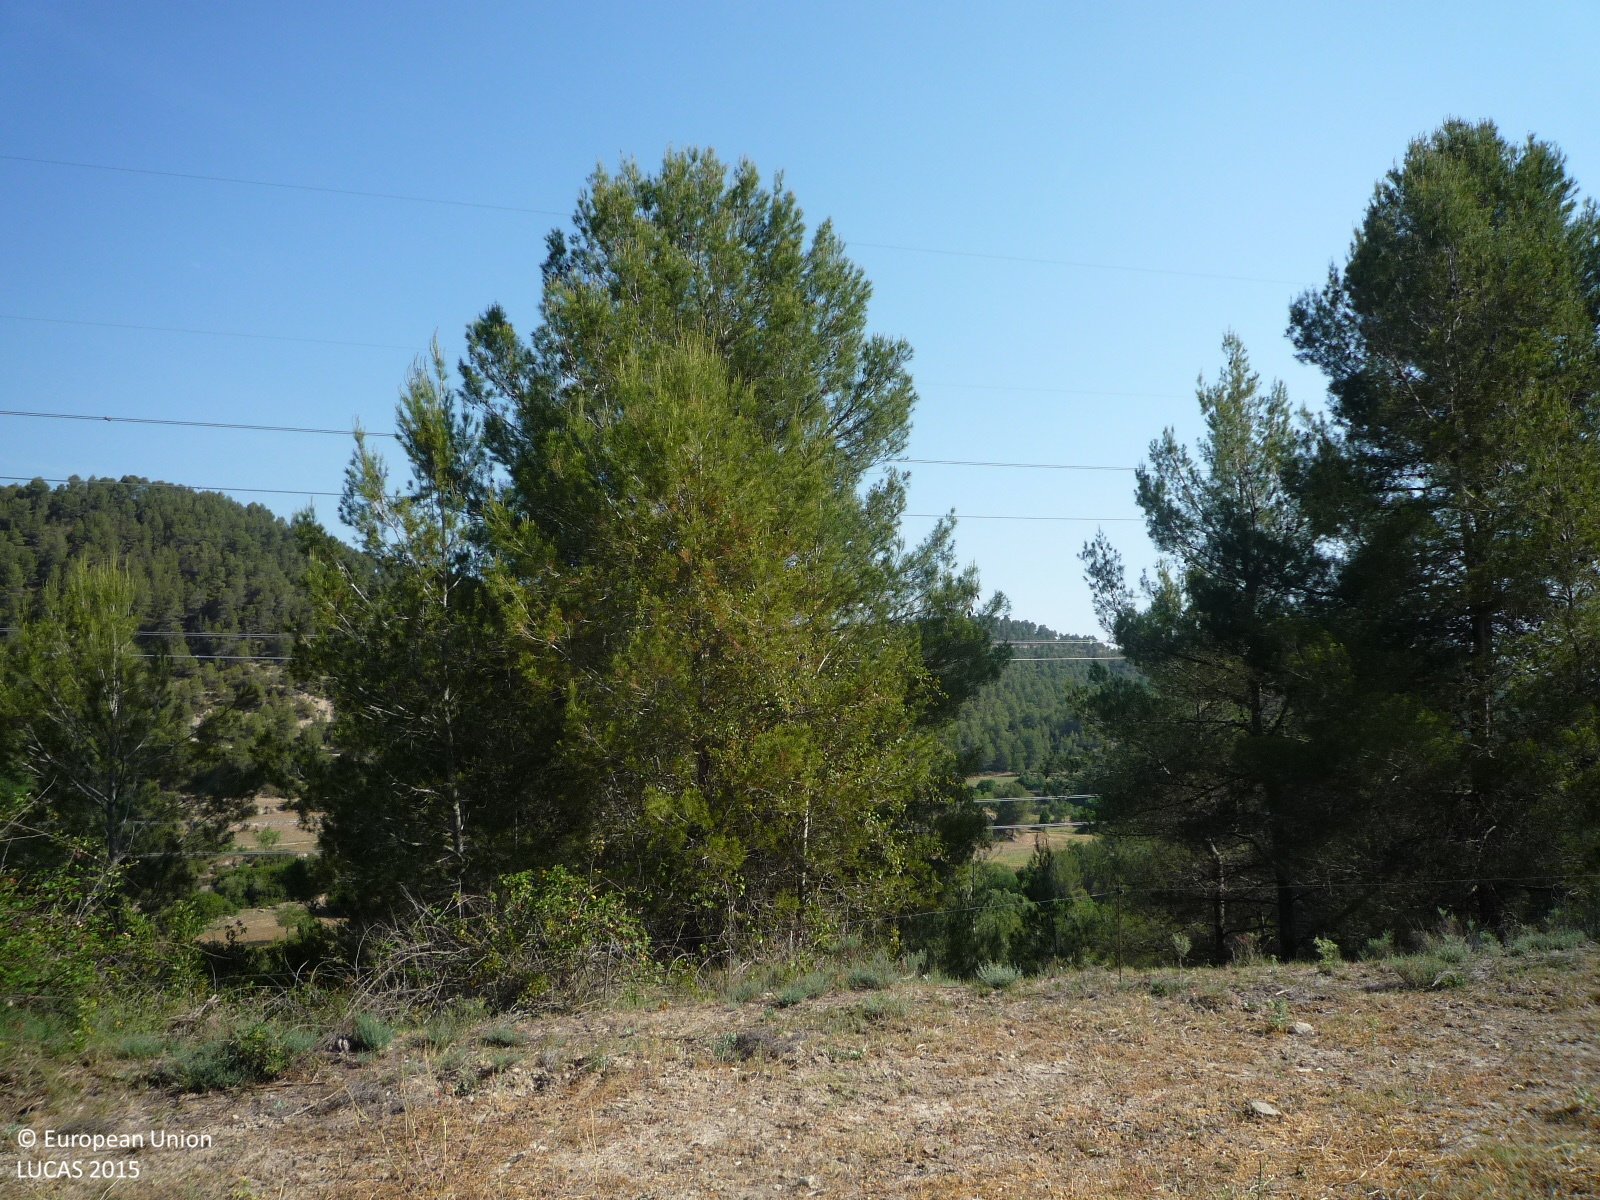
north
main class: Cropland
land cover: Temporary grasslands
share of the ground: > 75 %
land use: Agriculture (excluding fallow land and kitchen gardens)
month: June
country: ES
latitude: 41.6488
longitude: 1.7908
